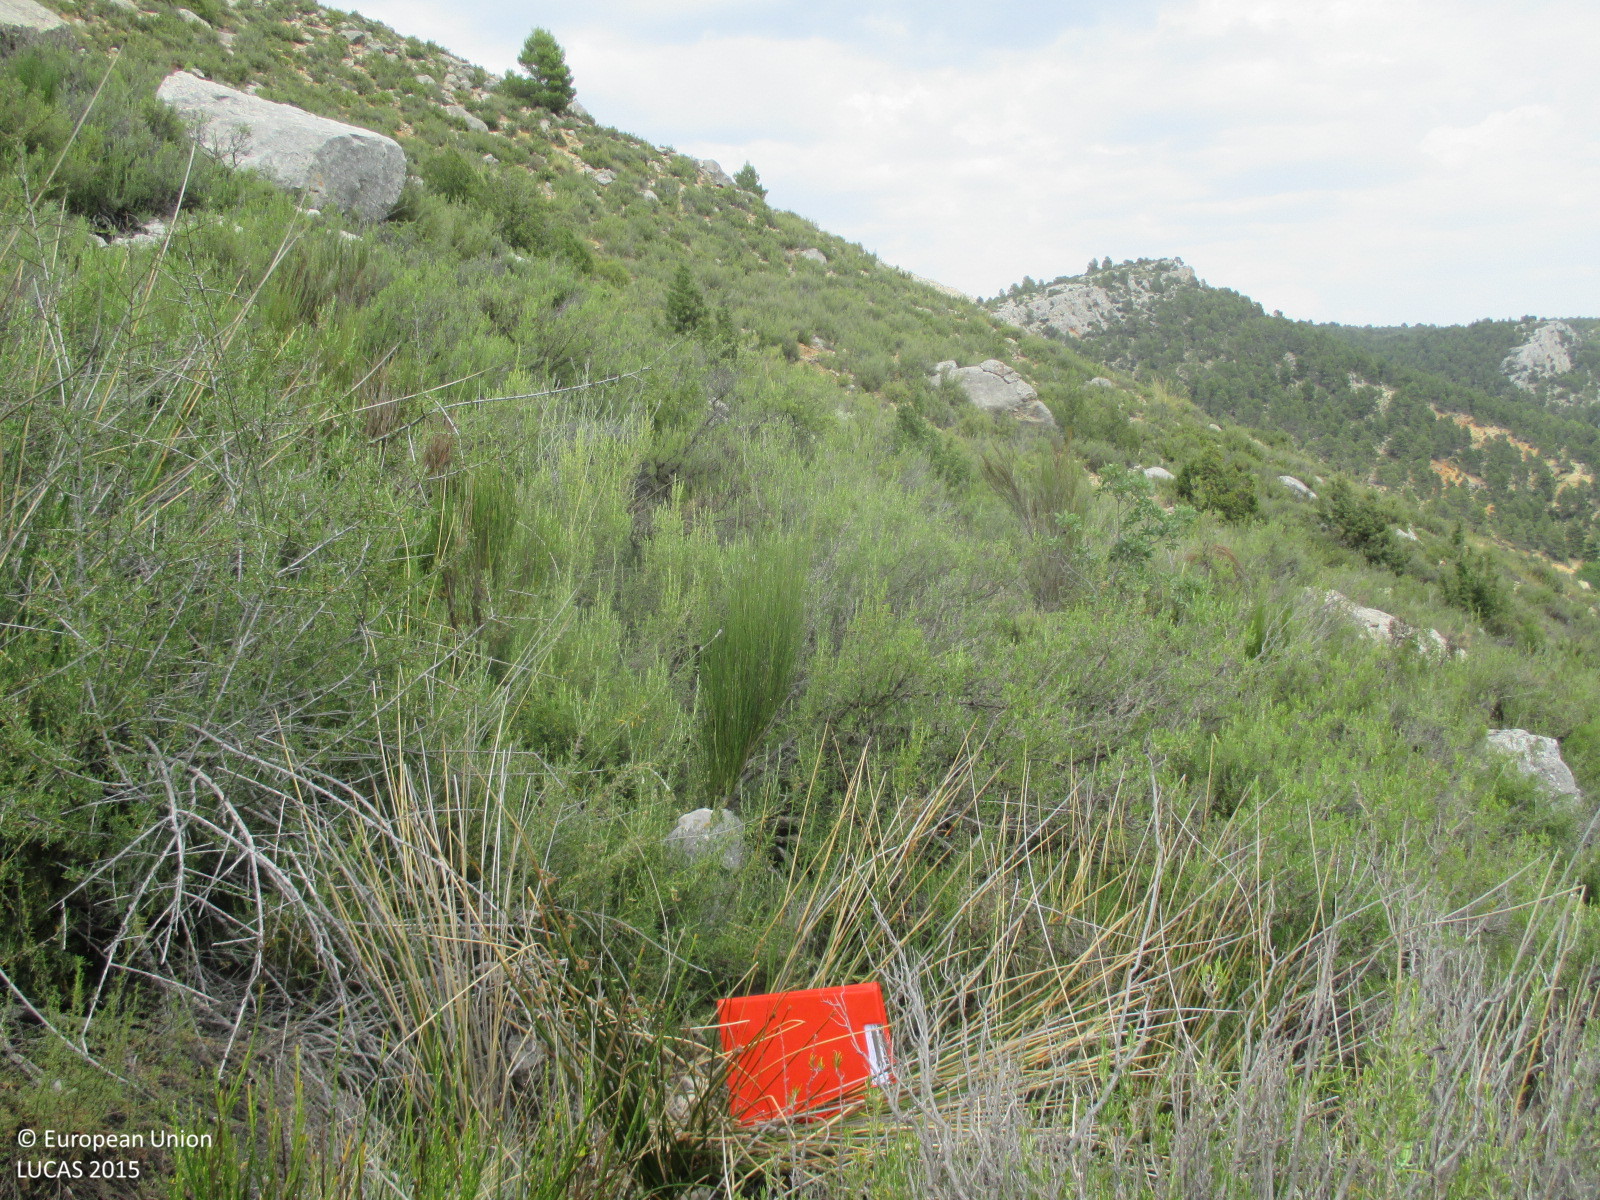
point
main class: Shrubland
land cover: Shrubland with sparse tree cover
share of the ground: > 75 %
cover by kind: shrubs 95 %, broadleaved forest trees 5 %
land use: Semi-natural and natural areas not in use
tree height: > 5 m
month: July
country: ES
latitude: 38.1480
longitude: -2.3512
